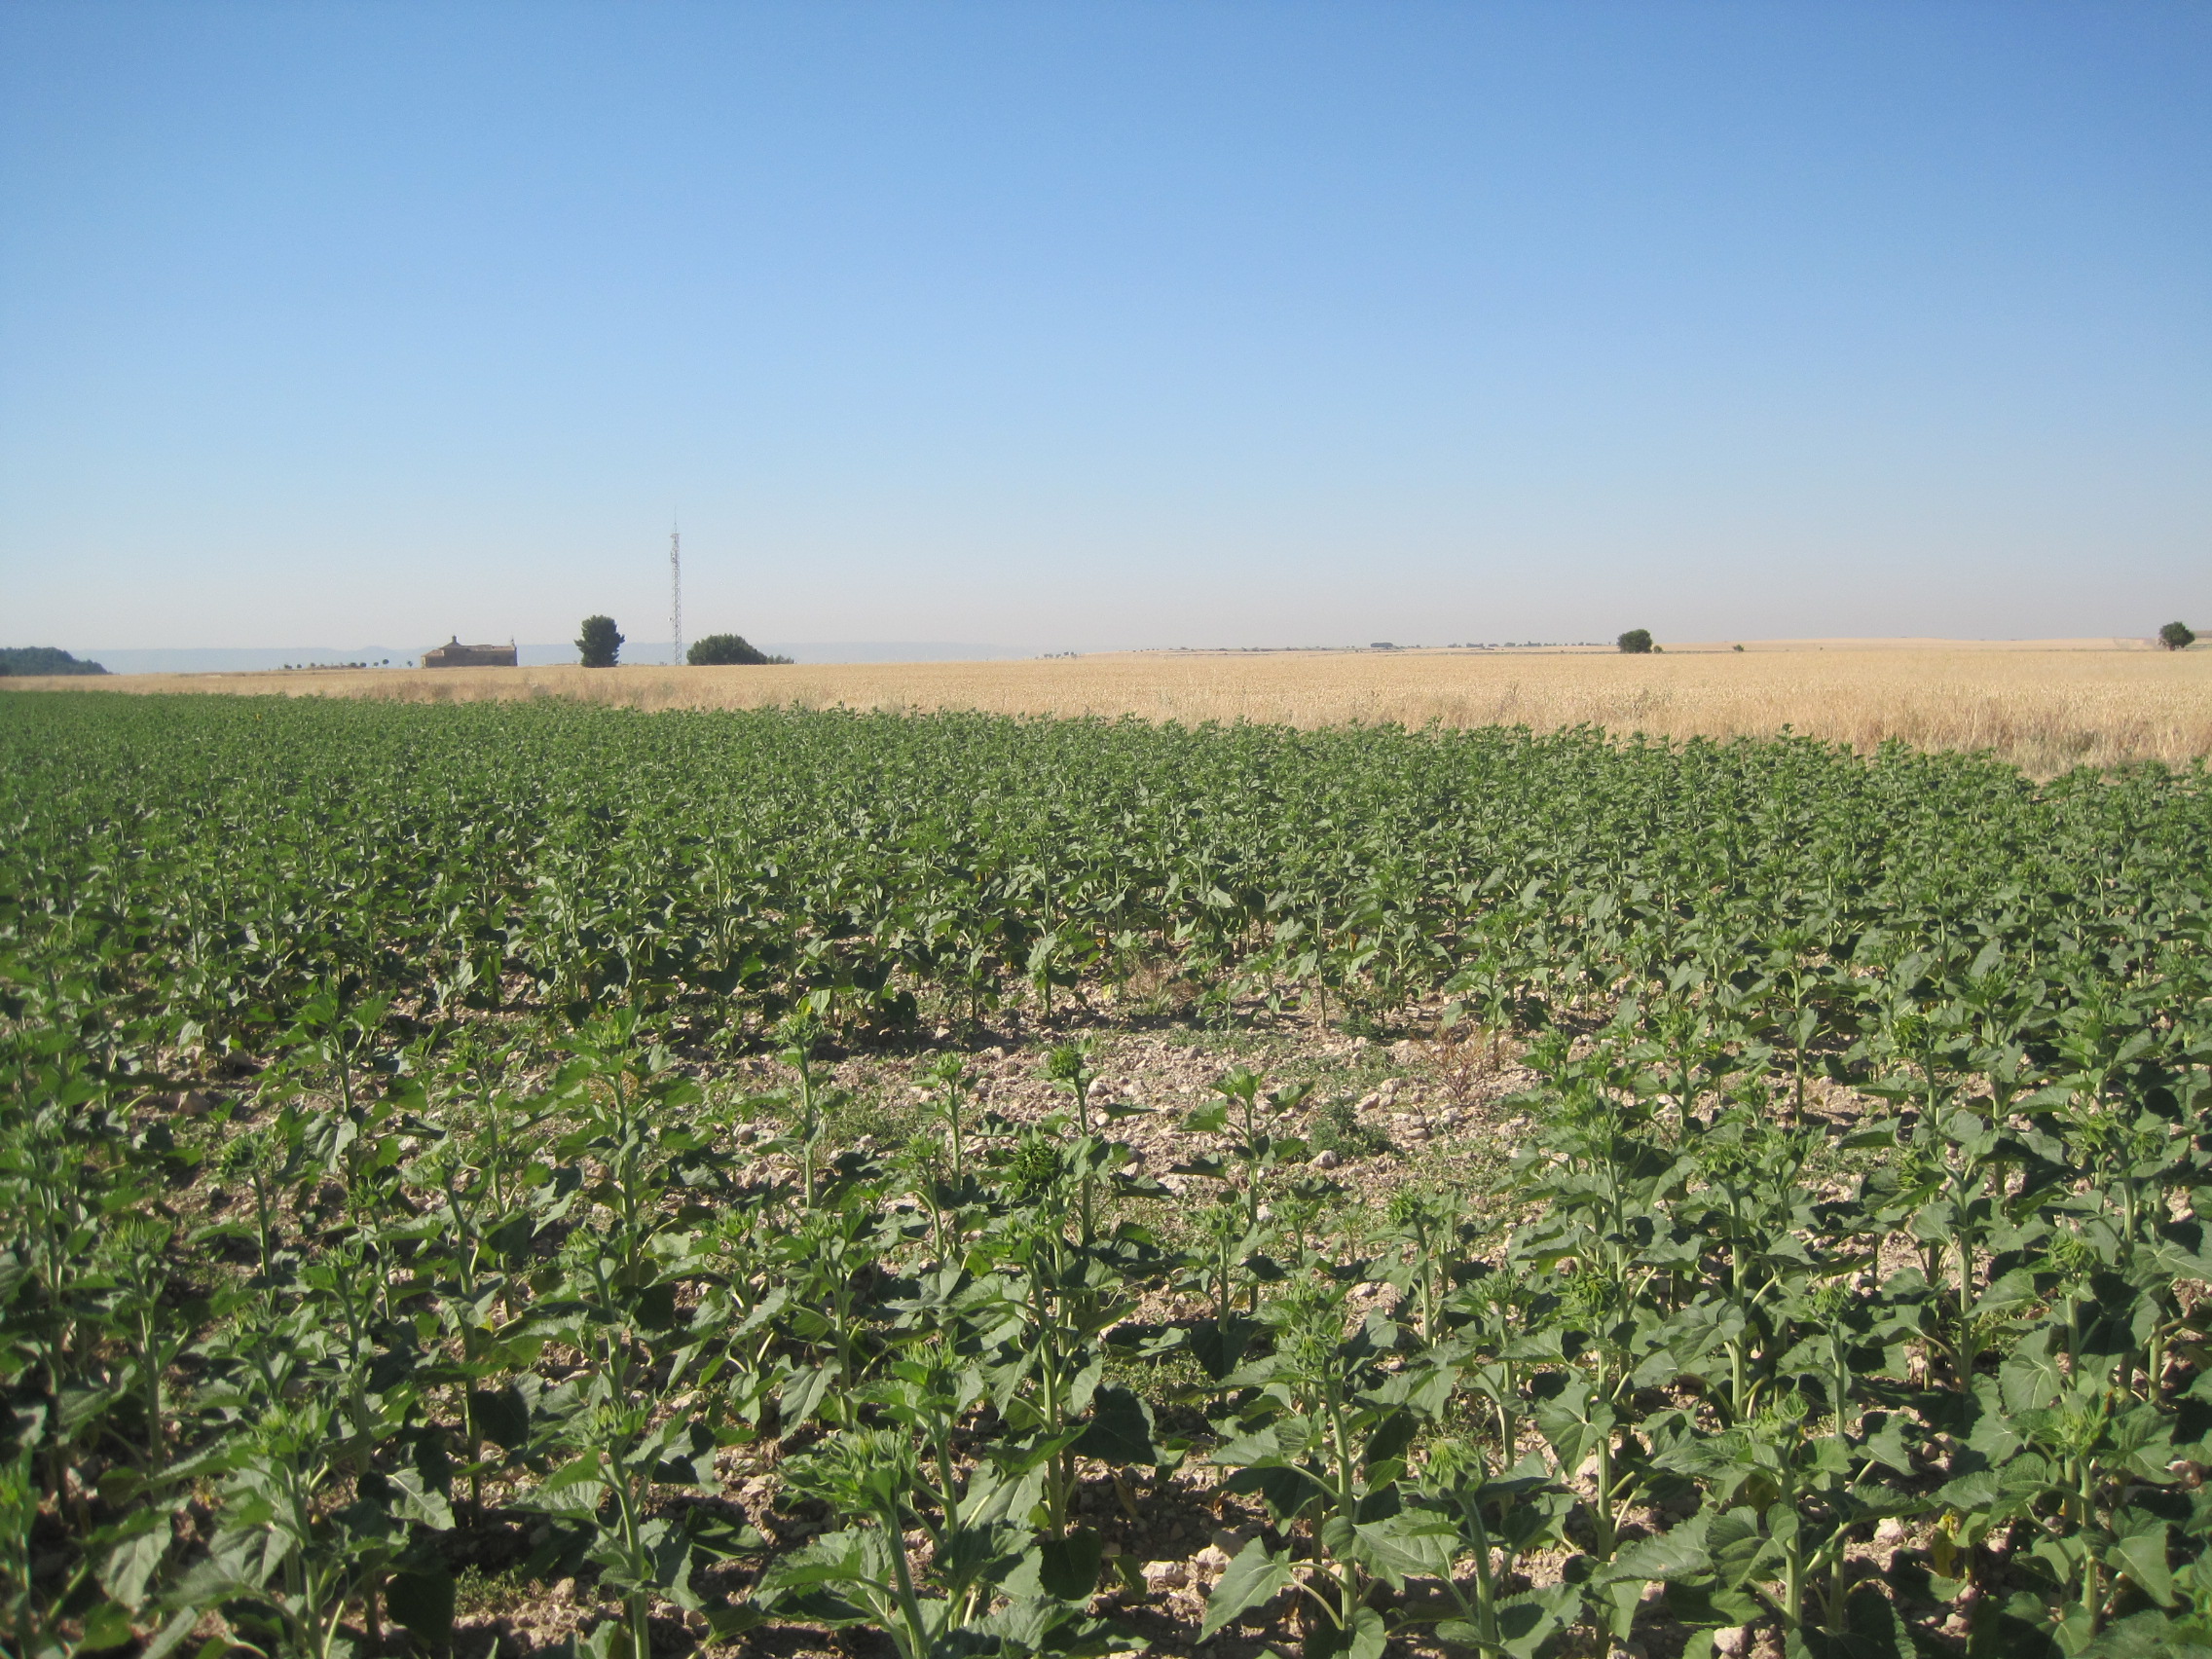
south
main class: Cropland
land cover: Sunflower
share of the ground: > 75 %
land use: Agriculture (excluding fallow land and kitchen gardens)
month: July
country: ES
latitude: 41.8383
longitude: -4.6535
